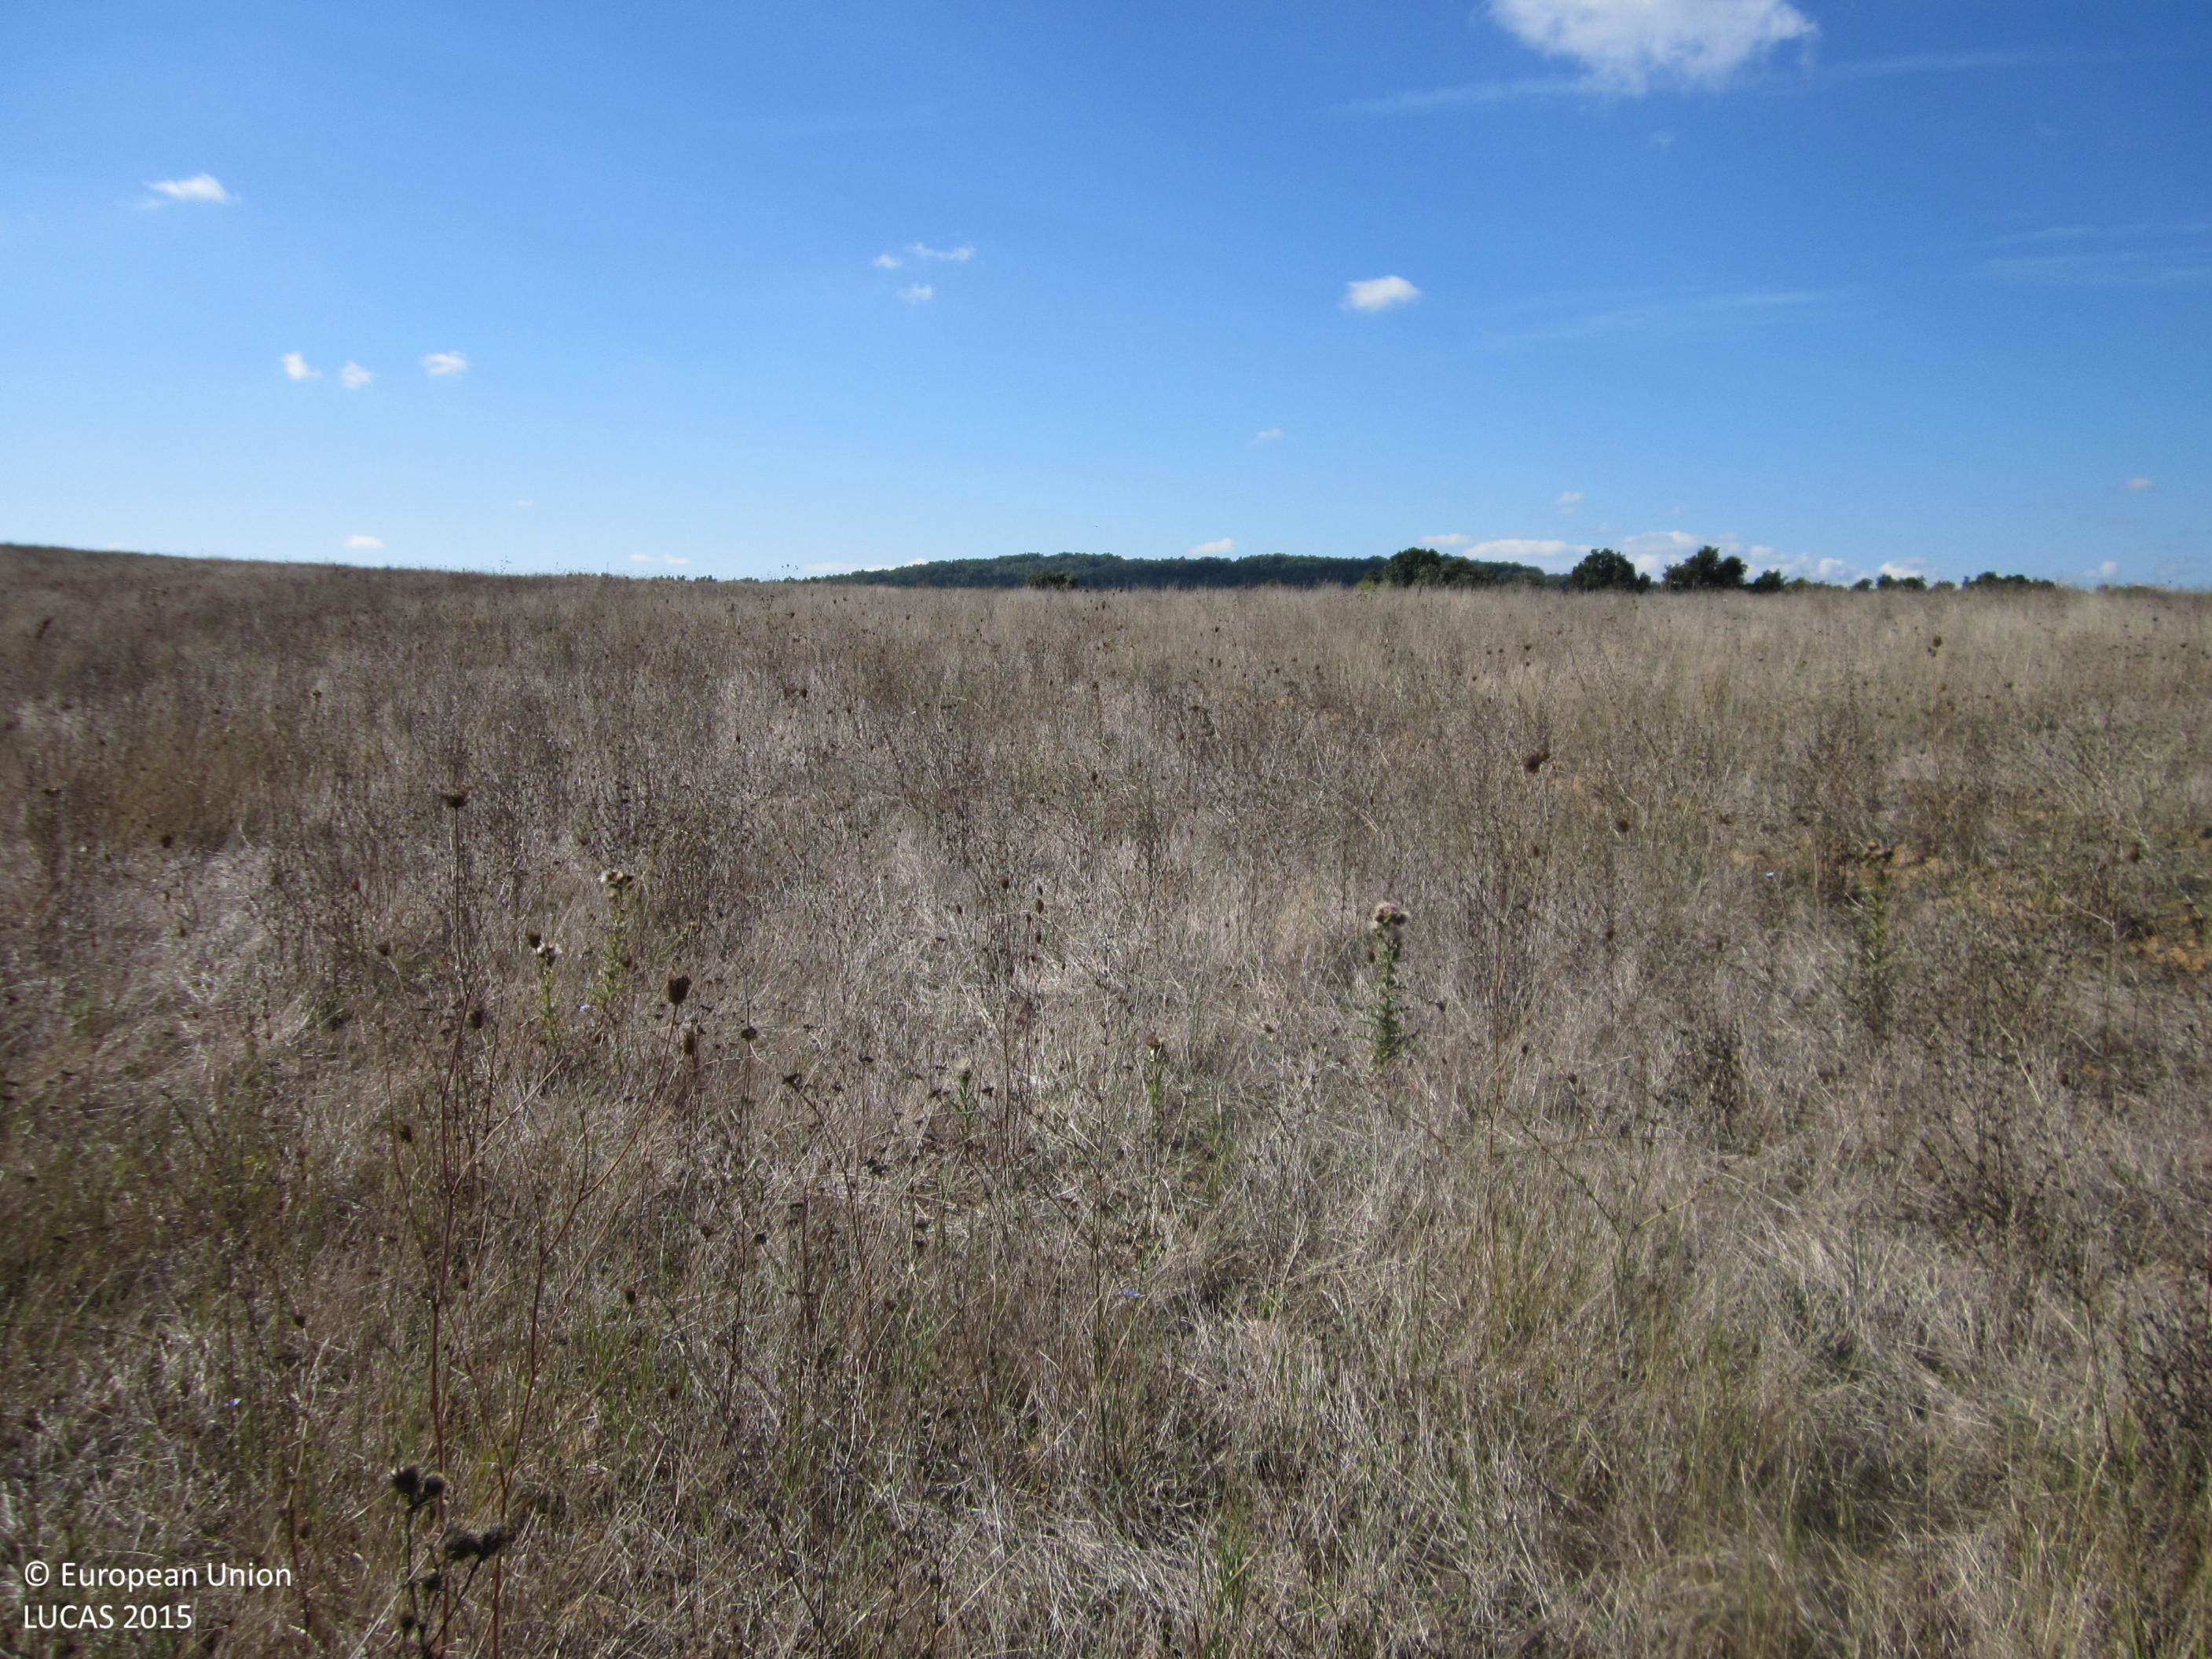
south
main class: Grassland
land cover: Spontaneously vegetated surfaces
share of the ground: > 75 %
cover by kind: herbaceous plants 95 %, unconsolidated bare surface 5 %
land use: Fallow land
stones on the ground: < 10 %
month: September
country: BG
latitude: 42.1444
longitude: 27.1032
